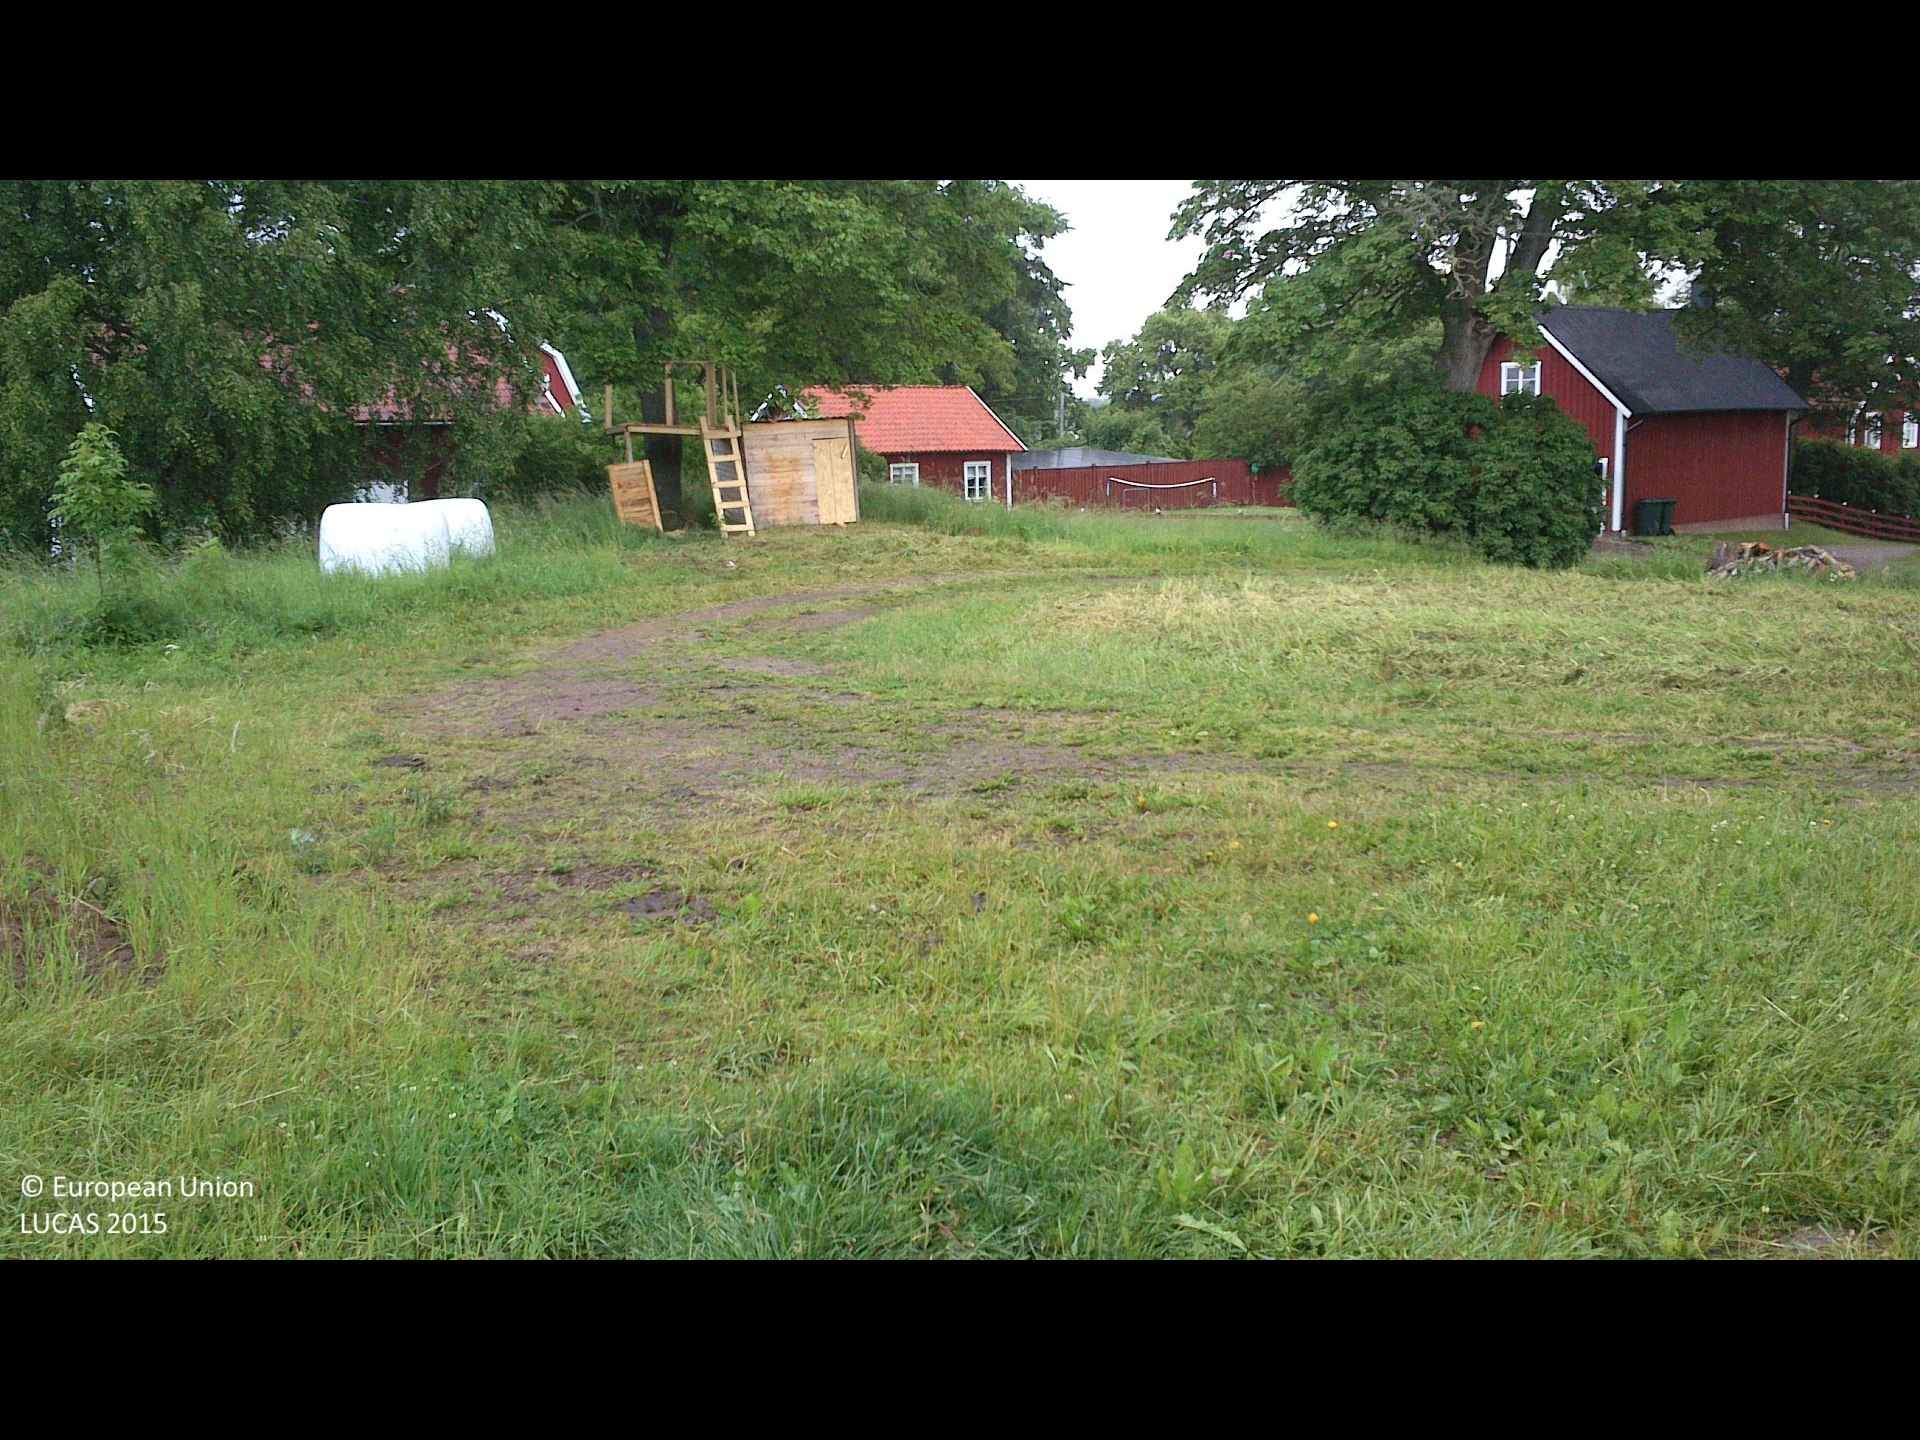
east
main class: Grassland
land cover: Grassland without tree/shrub cover
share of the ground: > 75 %
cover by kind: herbaceous plants 100 %
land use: Agriculture (excluding fallow land and kitchen gardens)
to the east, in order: Grassland without tree/shrub cover; Tracks; Grassland without tree/shrub cover; Tracks; Broadleaved woodland; Fences; Broadleaved woodland; Fences; Grassland with sparse tree/shrub cover; Paved roads, cycling and walking lanes; Ditches and canals; Fences; Grassland without tree/shrub cover; Fences; Spontaneously vegetated surfaces; Artificial constructions in urban areas; Lines of trees; Common wheat
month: June
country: SE
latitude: 58.1160
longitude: 15.7159
